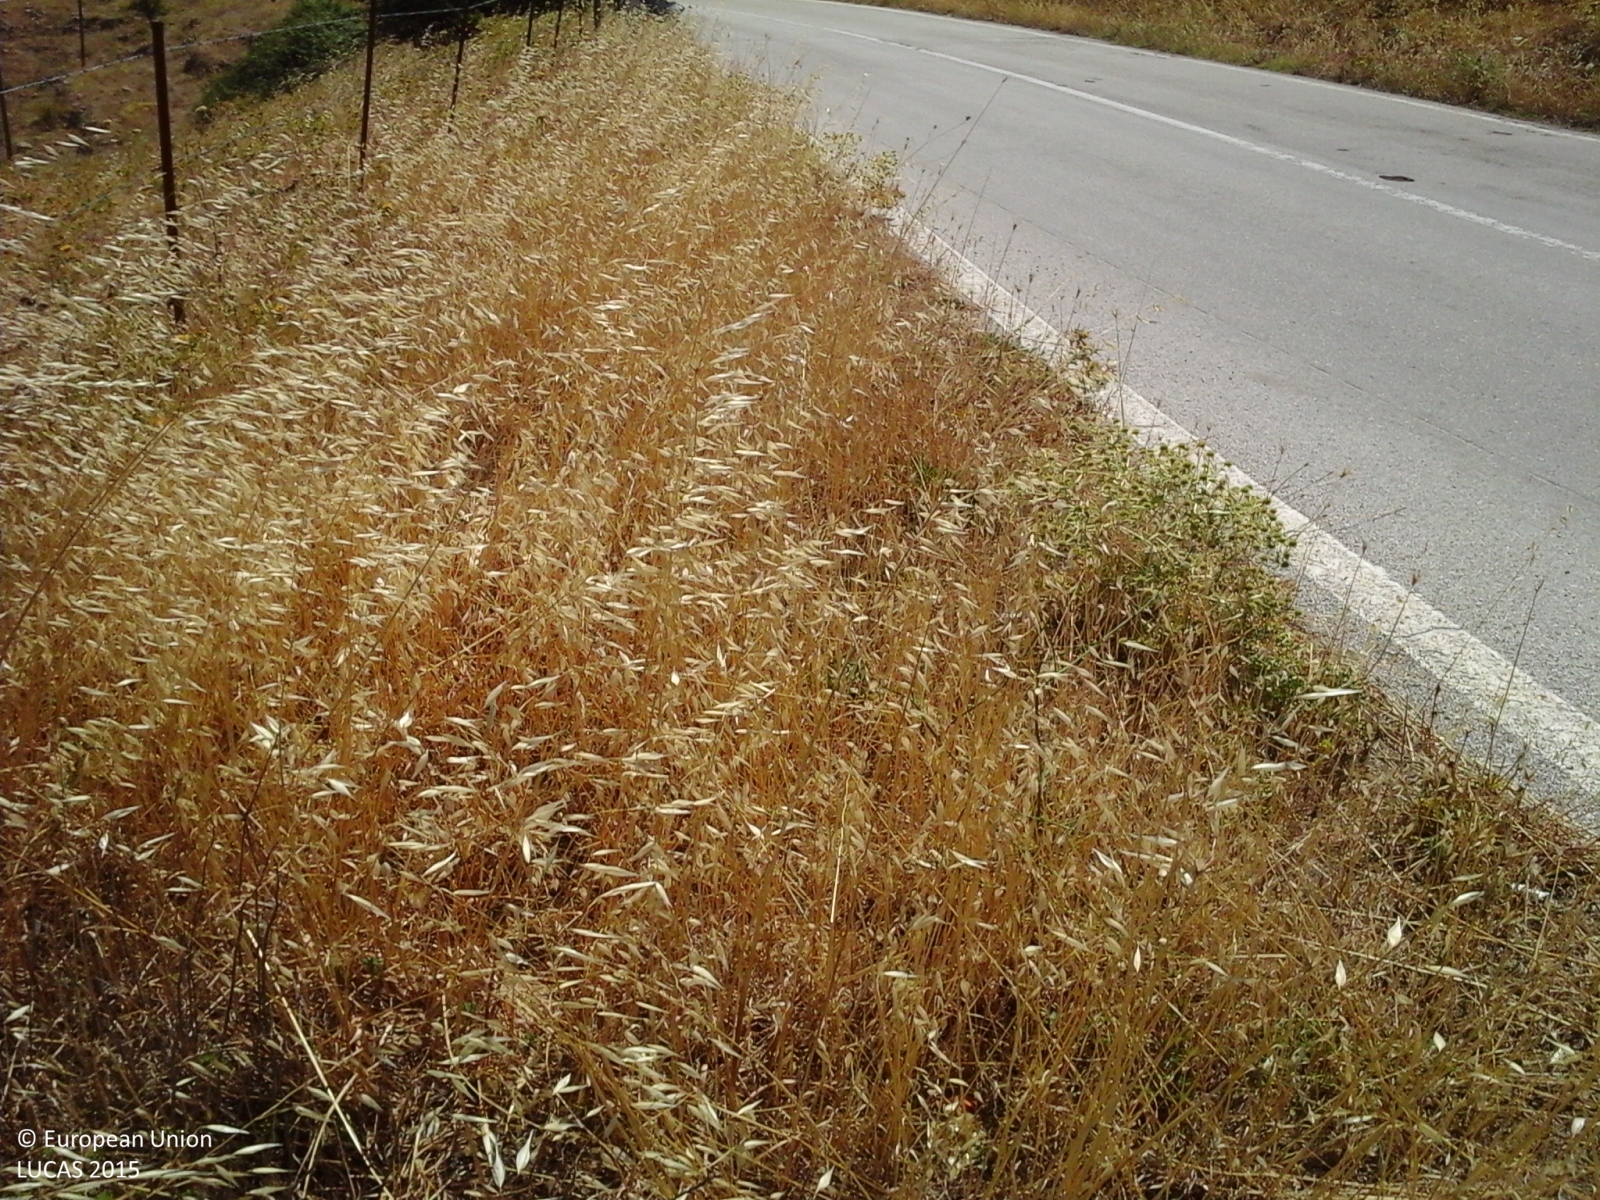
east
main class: Grassland
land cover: Grassland without tree/shrub cover
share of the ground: > 75 %
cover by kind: herbaceous plants 90 %, consolidated bare surface 10 %
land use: Agriculture (excluding fallow land and kitchen gardens)
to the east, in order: Grassland without tree/shrub cover; Grassland with sparse tree/shrub cover; Dry stone walls; Grassland with sparse tree/shrub cover; Rocks and stones; Shrubland with sparse tree cover
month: July
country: IT
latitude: 37.1152
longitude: 14.8358
